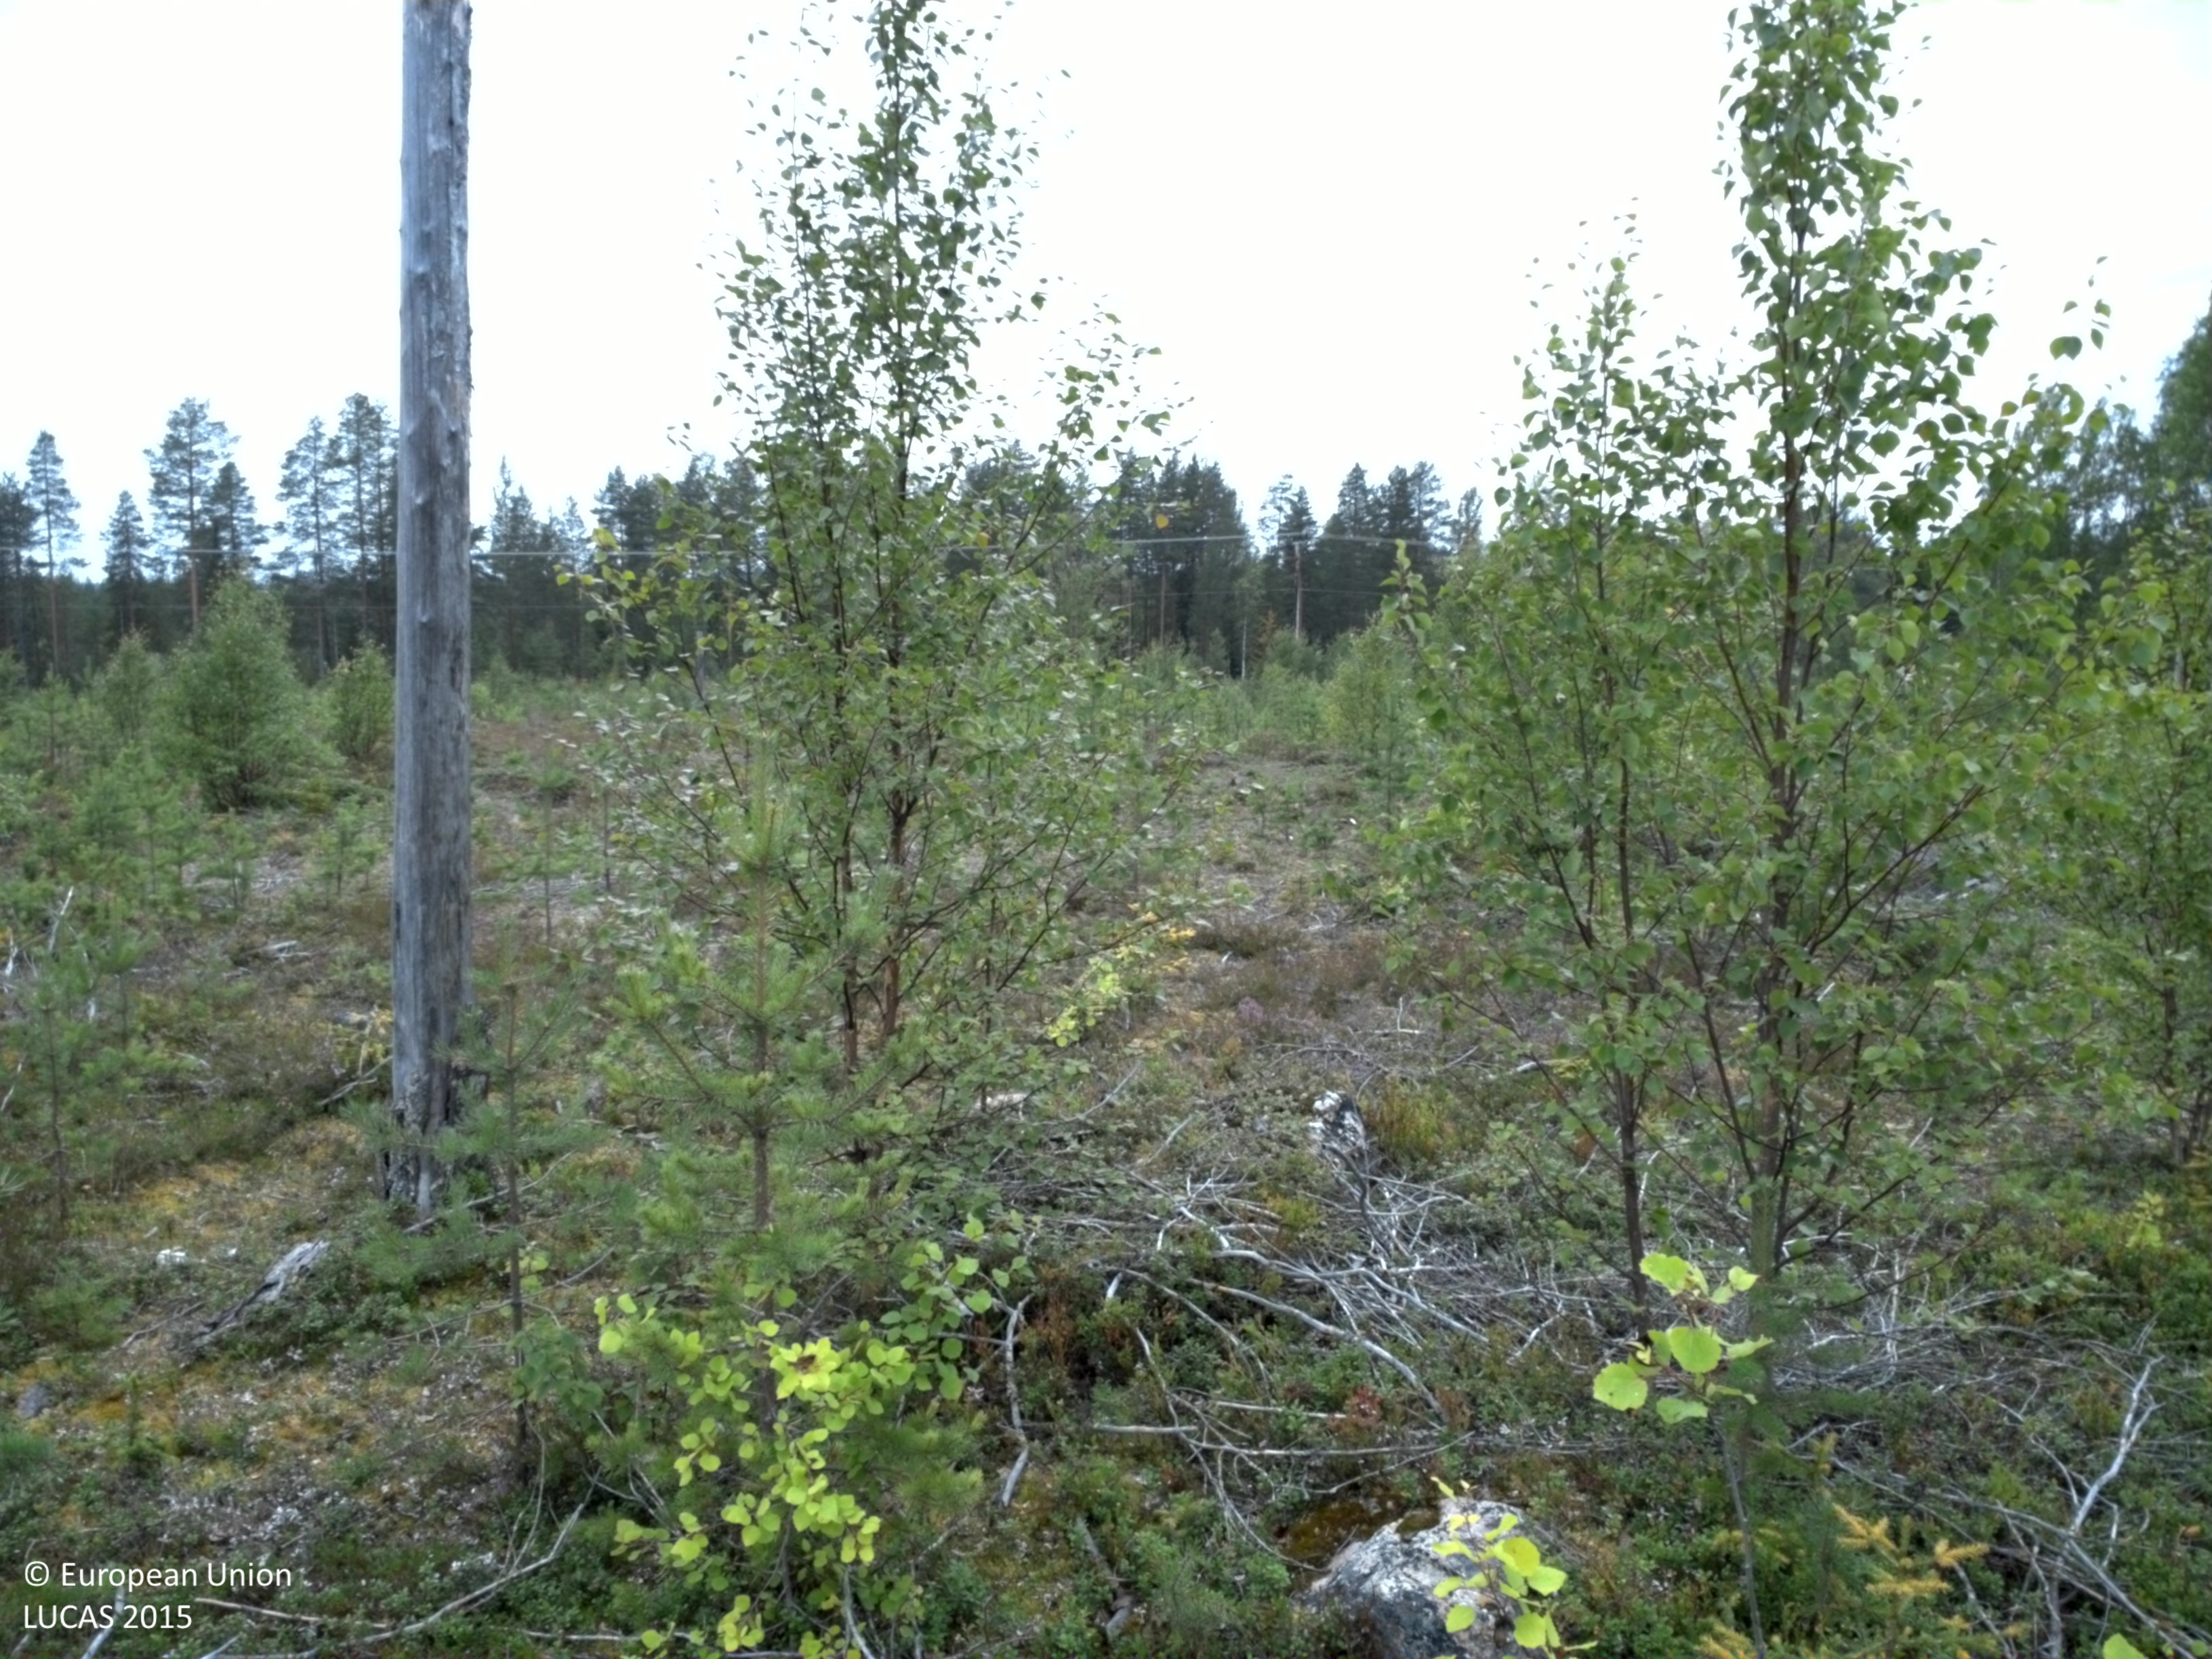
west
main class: Woodland
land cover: Pine dominated mixed woodland
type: boreal forest
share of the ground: 25 - 50 %
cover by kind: shrubs 60 %, broadleaved forest trees 20 %, coniferous forest trees 10 %, lichens and mosses 10 %
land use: Forestry
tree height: < 5 m
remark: Clear cut
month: August
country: SE
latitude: 65.9974
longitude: 22.6924
